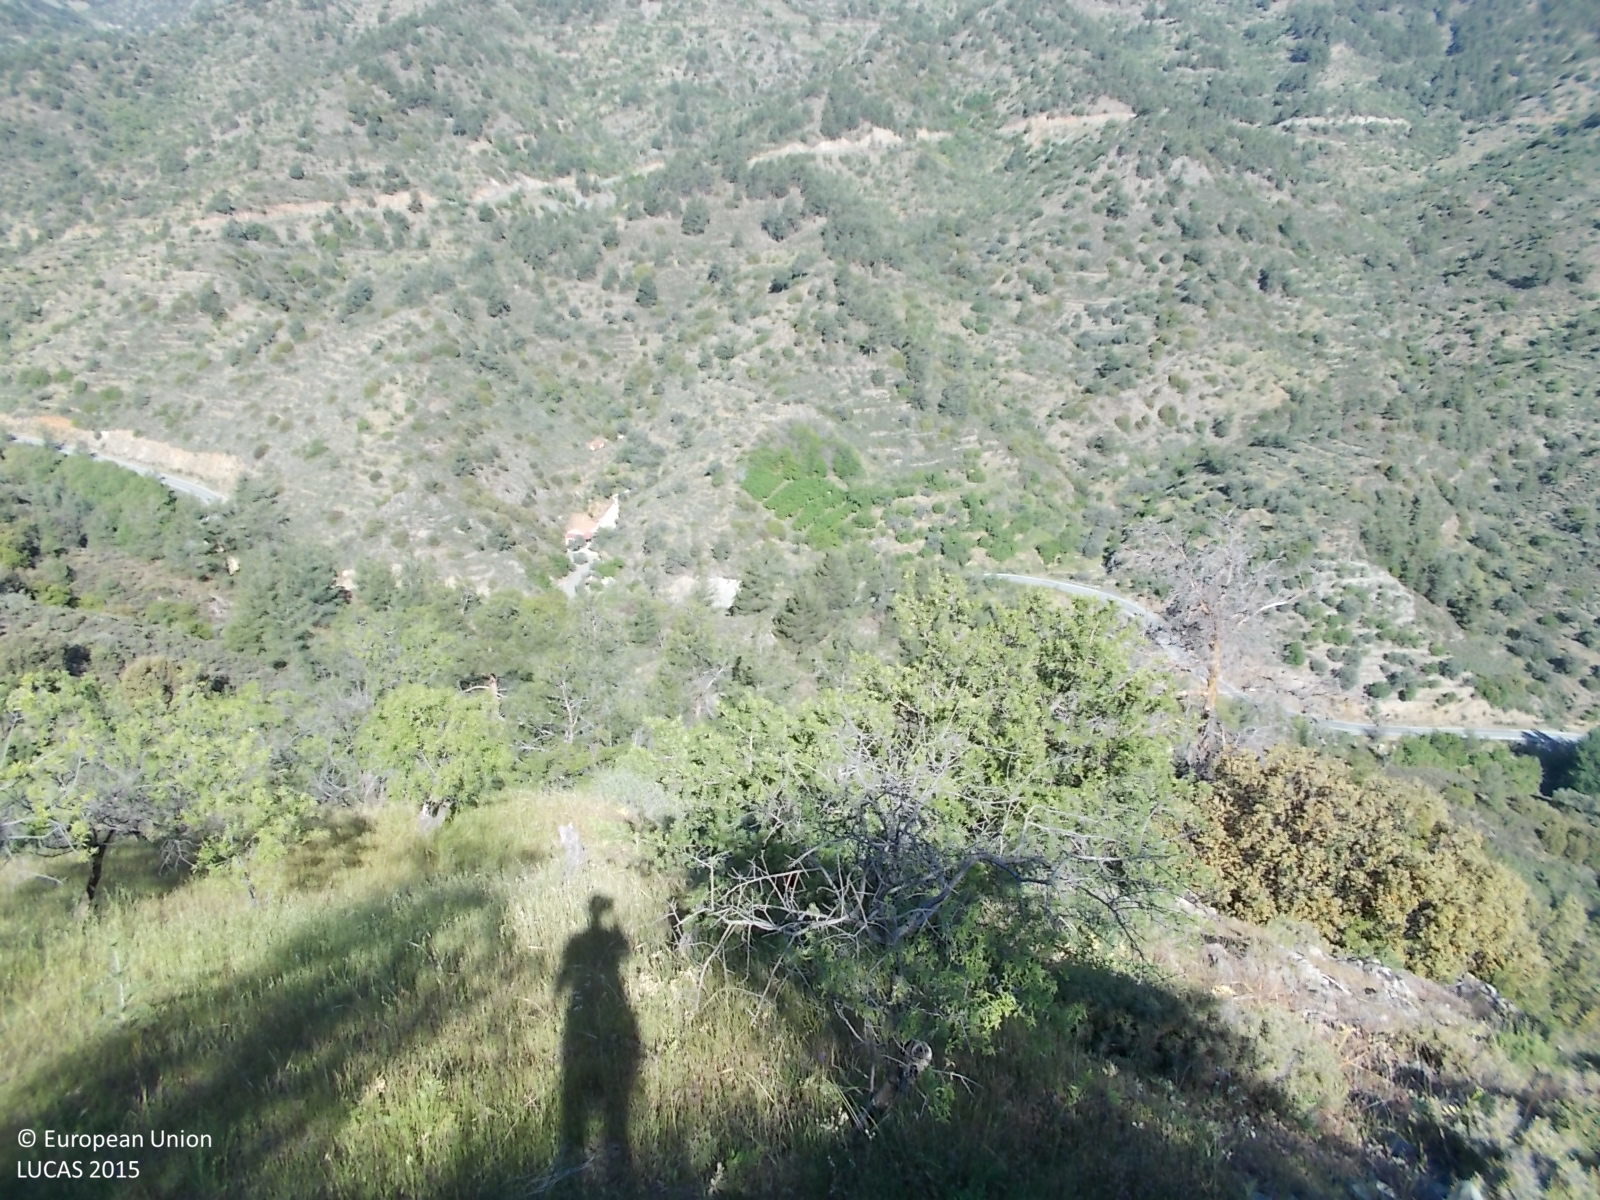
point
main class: Woodland
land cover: Pine dominated coniferous woodland
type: coniferous forest of the mediterranean region
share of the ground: > 75 %
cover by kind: coniferous forest trees 100 %
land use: Semi-natural and natural areas not in use
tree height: > 5 m
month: May
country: CY
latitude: 34.9676
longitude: 33.0545
